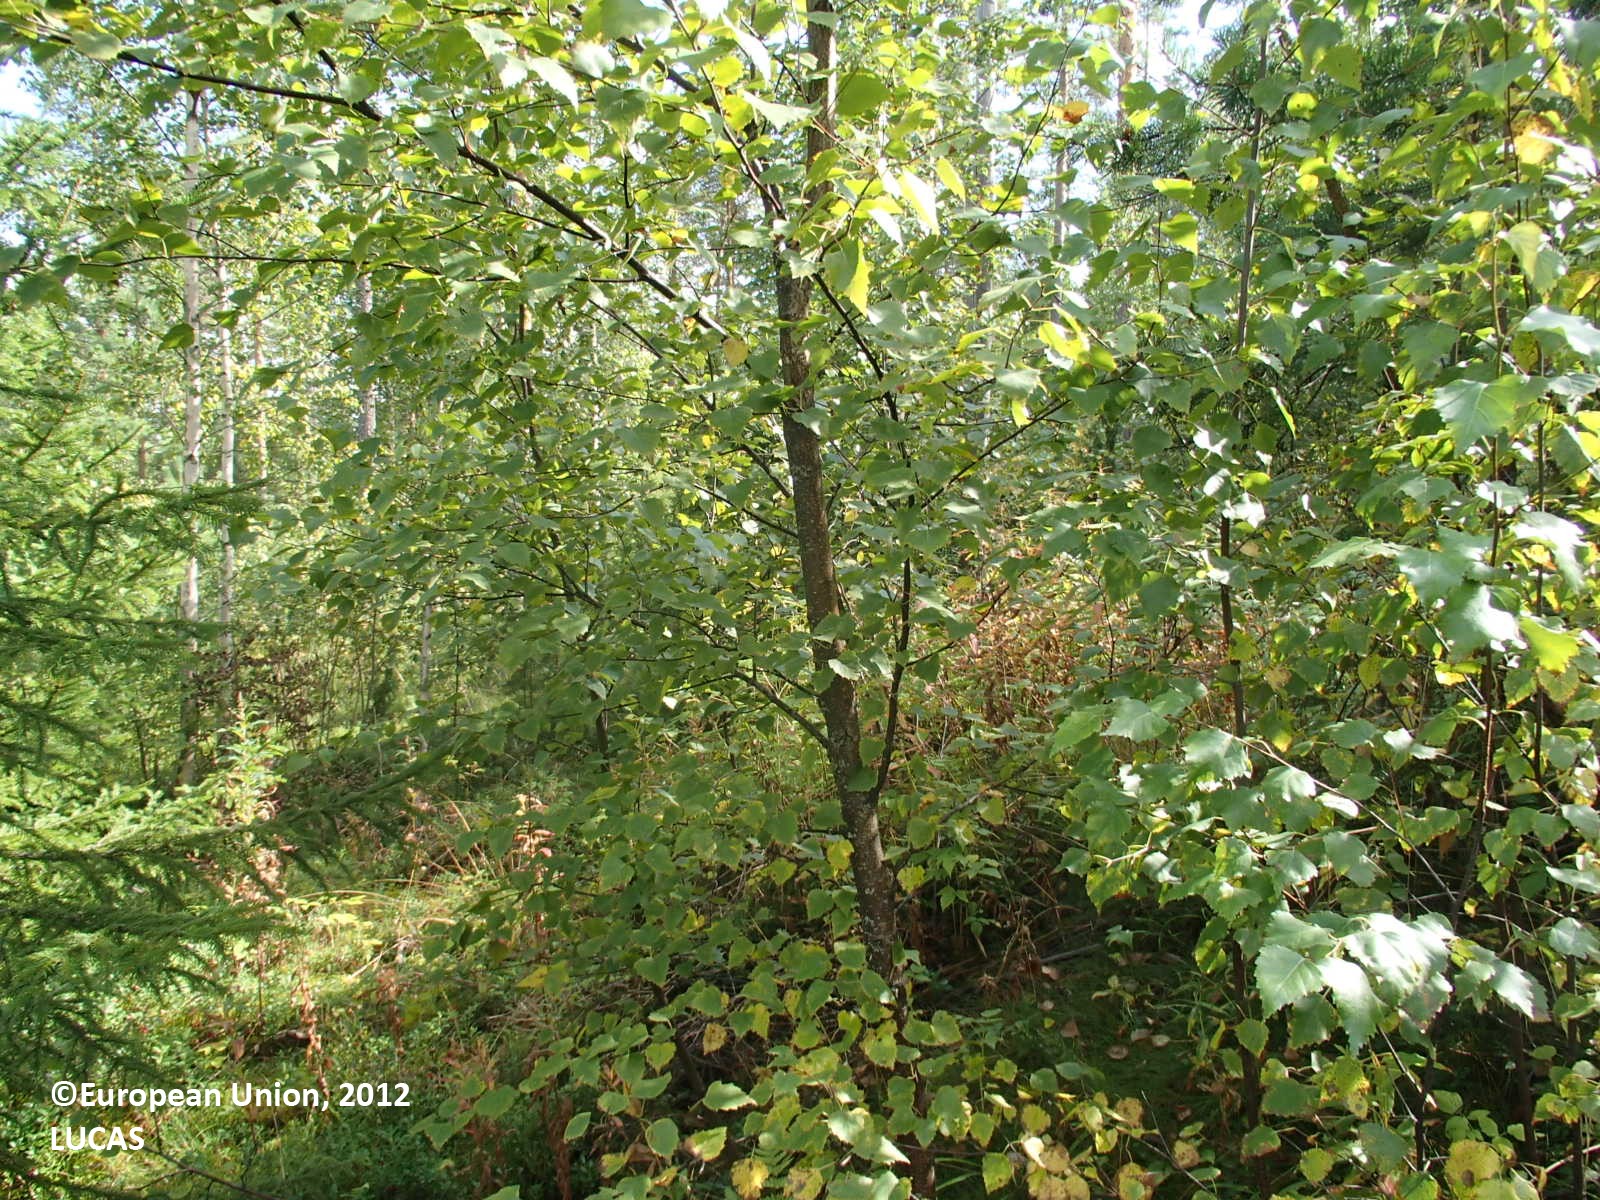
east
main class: Woodland
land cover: Other mixed woodland
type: boreal forest
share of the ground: 50 - 75 %
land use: Forestry
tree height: > 5 m
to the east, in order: Other mixed woodland; Other coniferous woodland
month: August
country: FI
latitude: 63.5161
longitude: 27.0866
